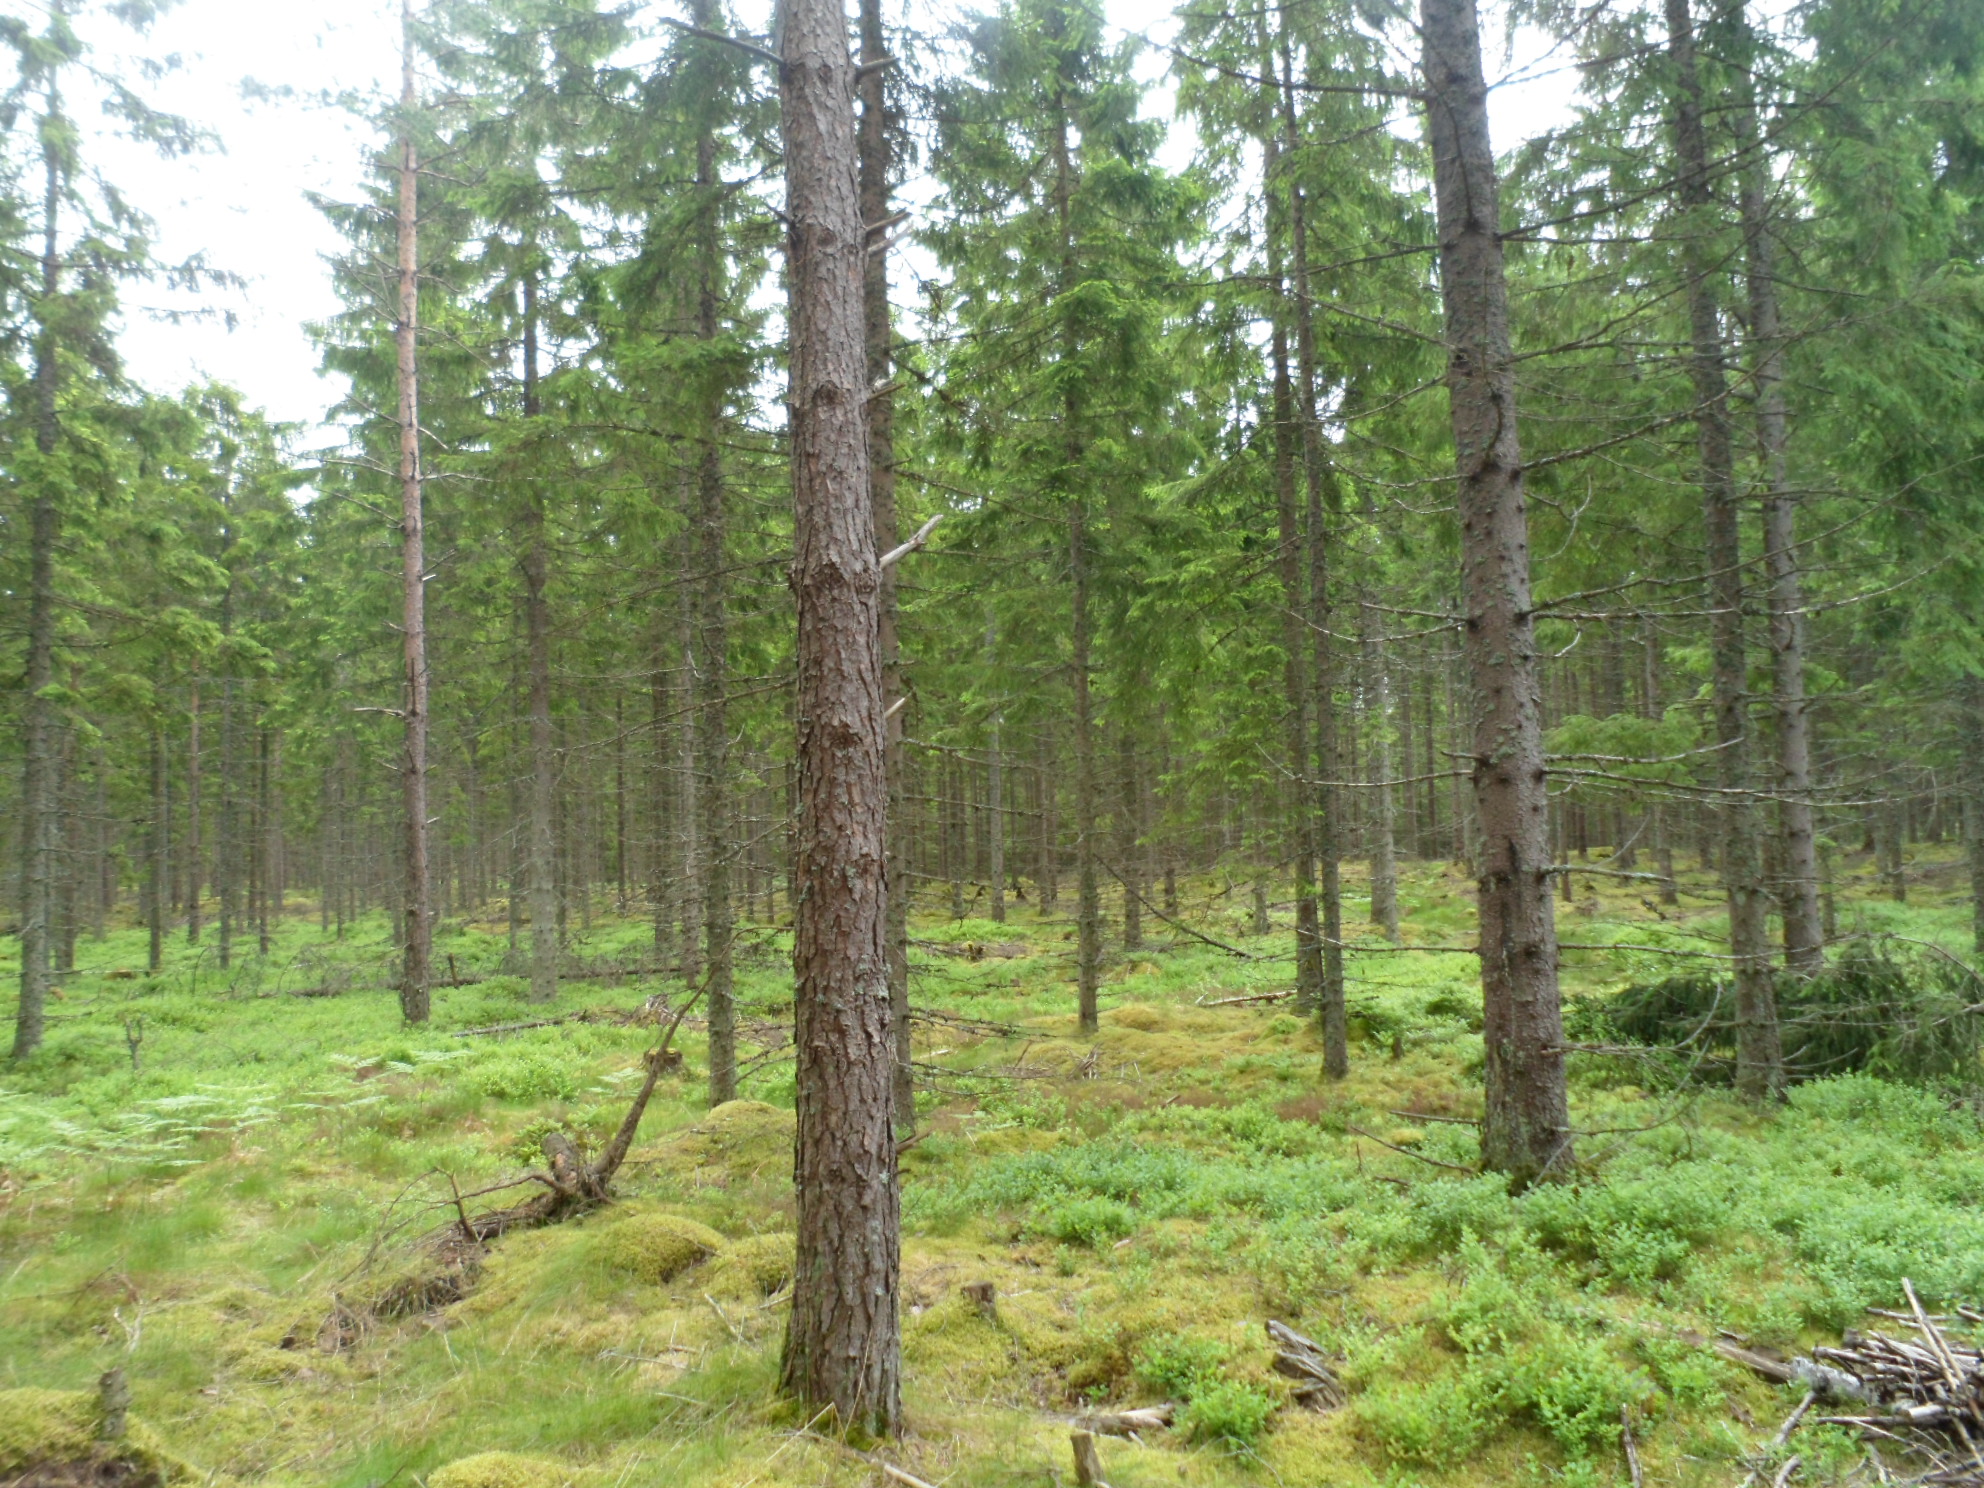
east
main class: Woodland
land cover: Spruce dominated coniferous woodland
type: boreal forest
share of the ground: 50 - 75 %
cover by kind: coniferous forest trees 55 %, lichens and mosses 30 %, shrubs 10 %, herbaceous plants 5 %
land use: Forestry
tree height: > 5 m
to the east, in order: Spruce dominated coniferous woodland; Spruce dominated mixed woodland; Spruce dominated coniferous woodland; Tracks; Spruce dominated coniferous woodland
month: June
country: SE
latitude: 57.0546
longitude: 15.2237
